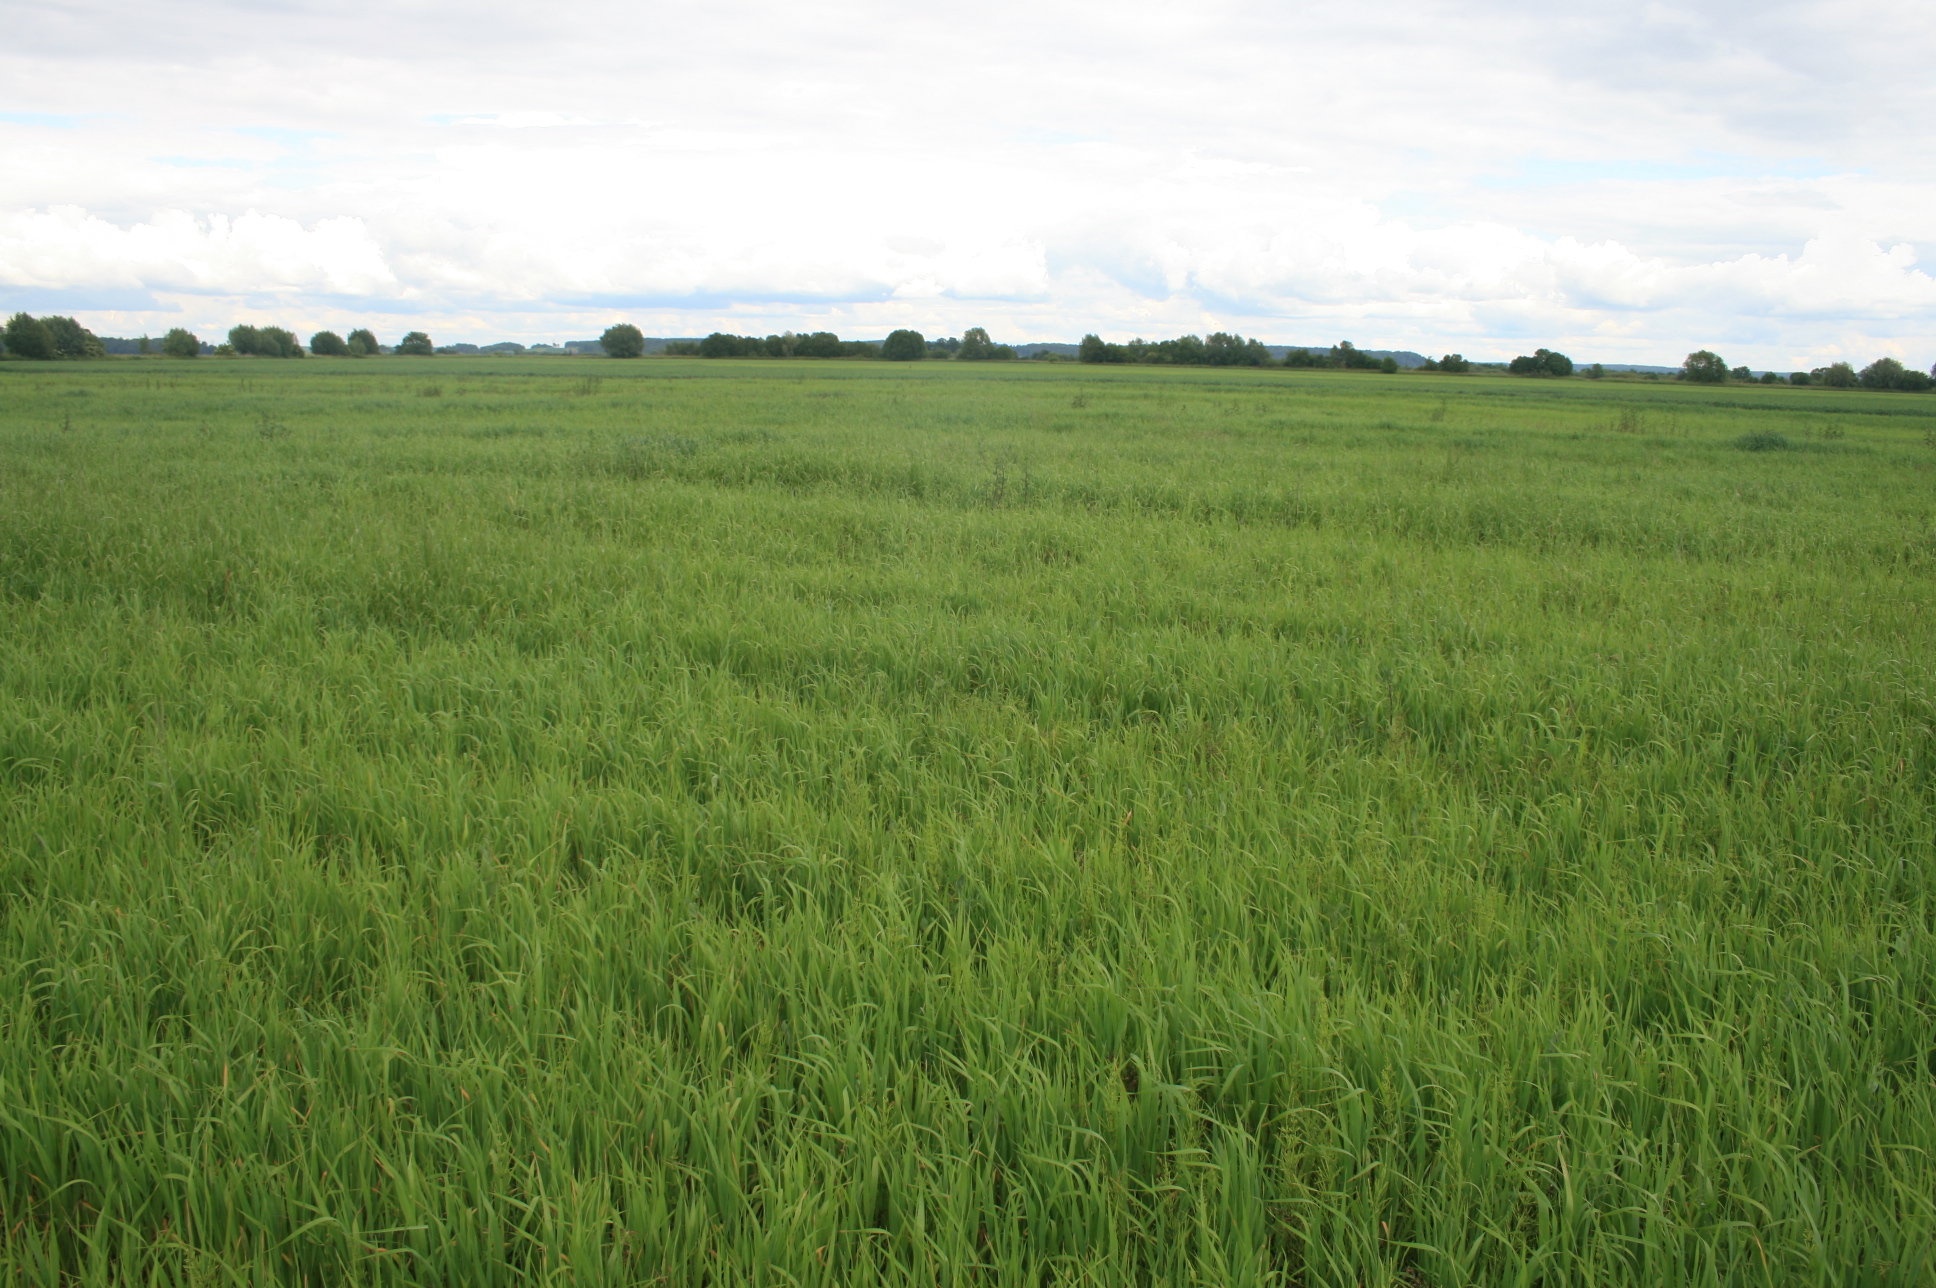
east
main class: Cropland
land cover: Mixed cereals for fodder
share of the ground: > 75 %
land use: Agriculture (excluding fallow land and kitchen gardens)
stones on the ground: < 10 %
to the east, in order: Mixed cereals for fodder; Common wheat; Barley
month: June
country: LT
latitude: 55.0994
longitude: 21.9484
